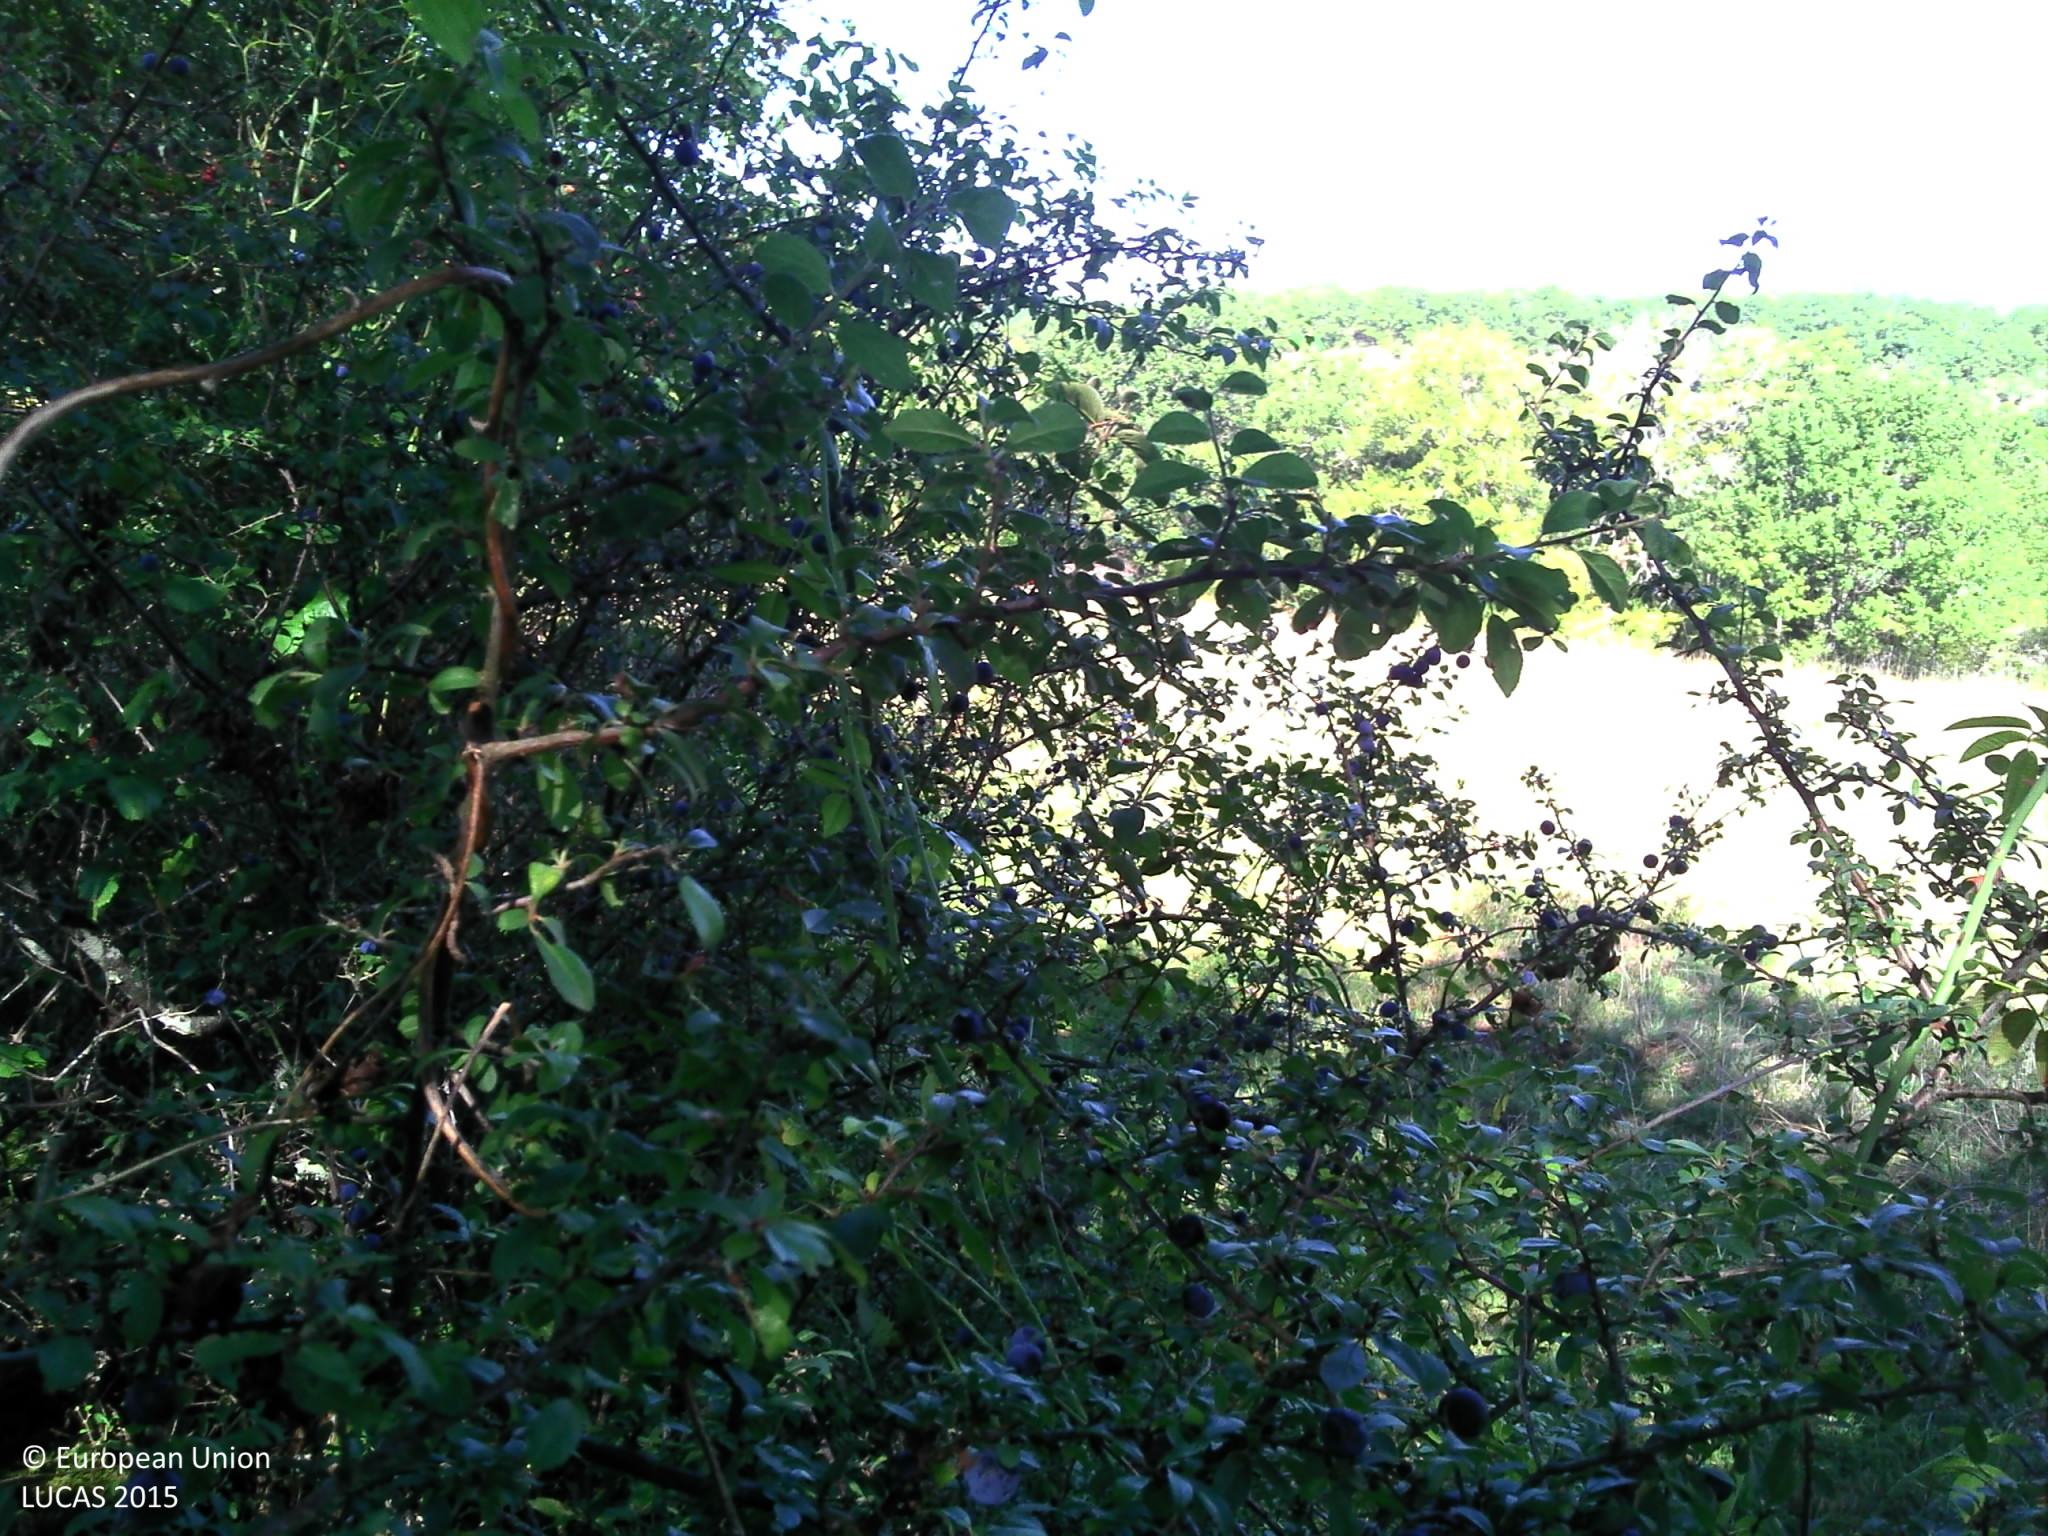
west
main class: Grassland
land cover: Grassland without tree/shrub cover
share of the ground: > 75 %
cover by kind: herbaceous plants 100 %
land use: Agriculture (excluding fallow land and kitchen gardens)
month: August
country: FR
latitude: 44.2508
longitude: 1.8984
